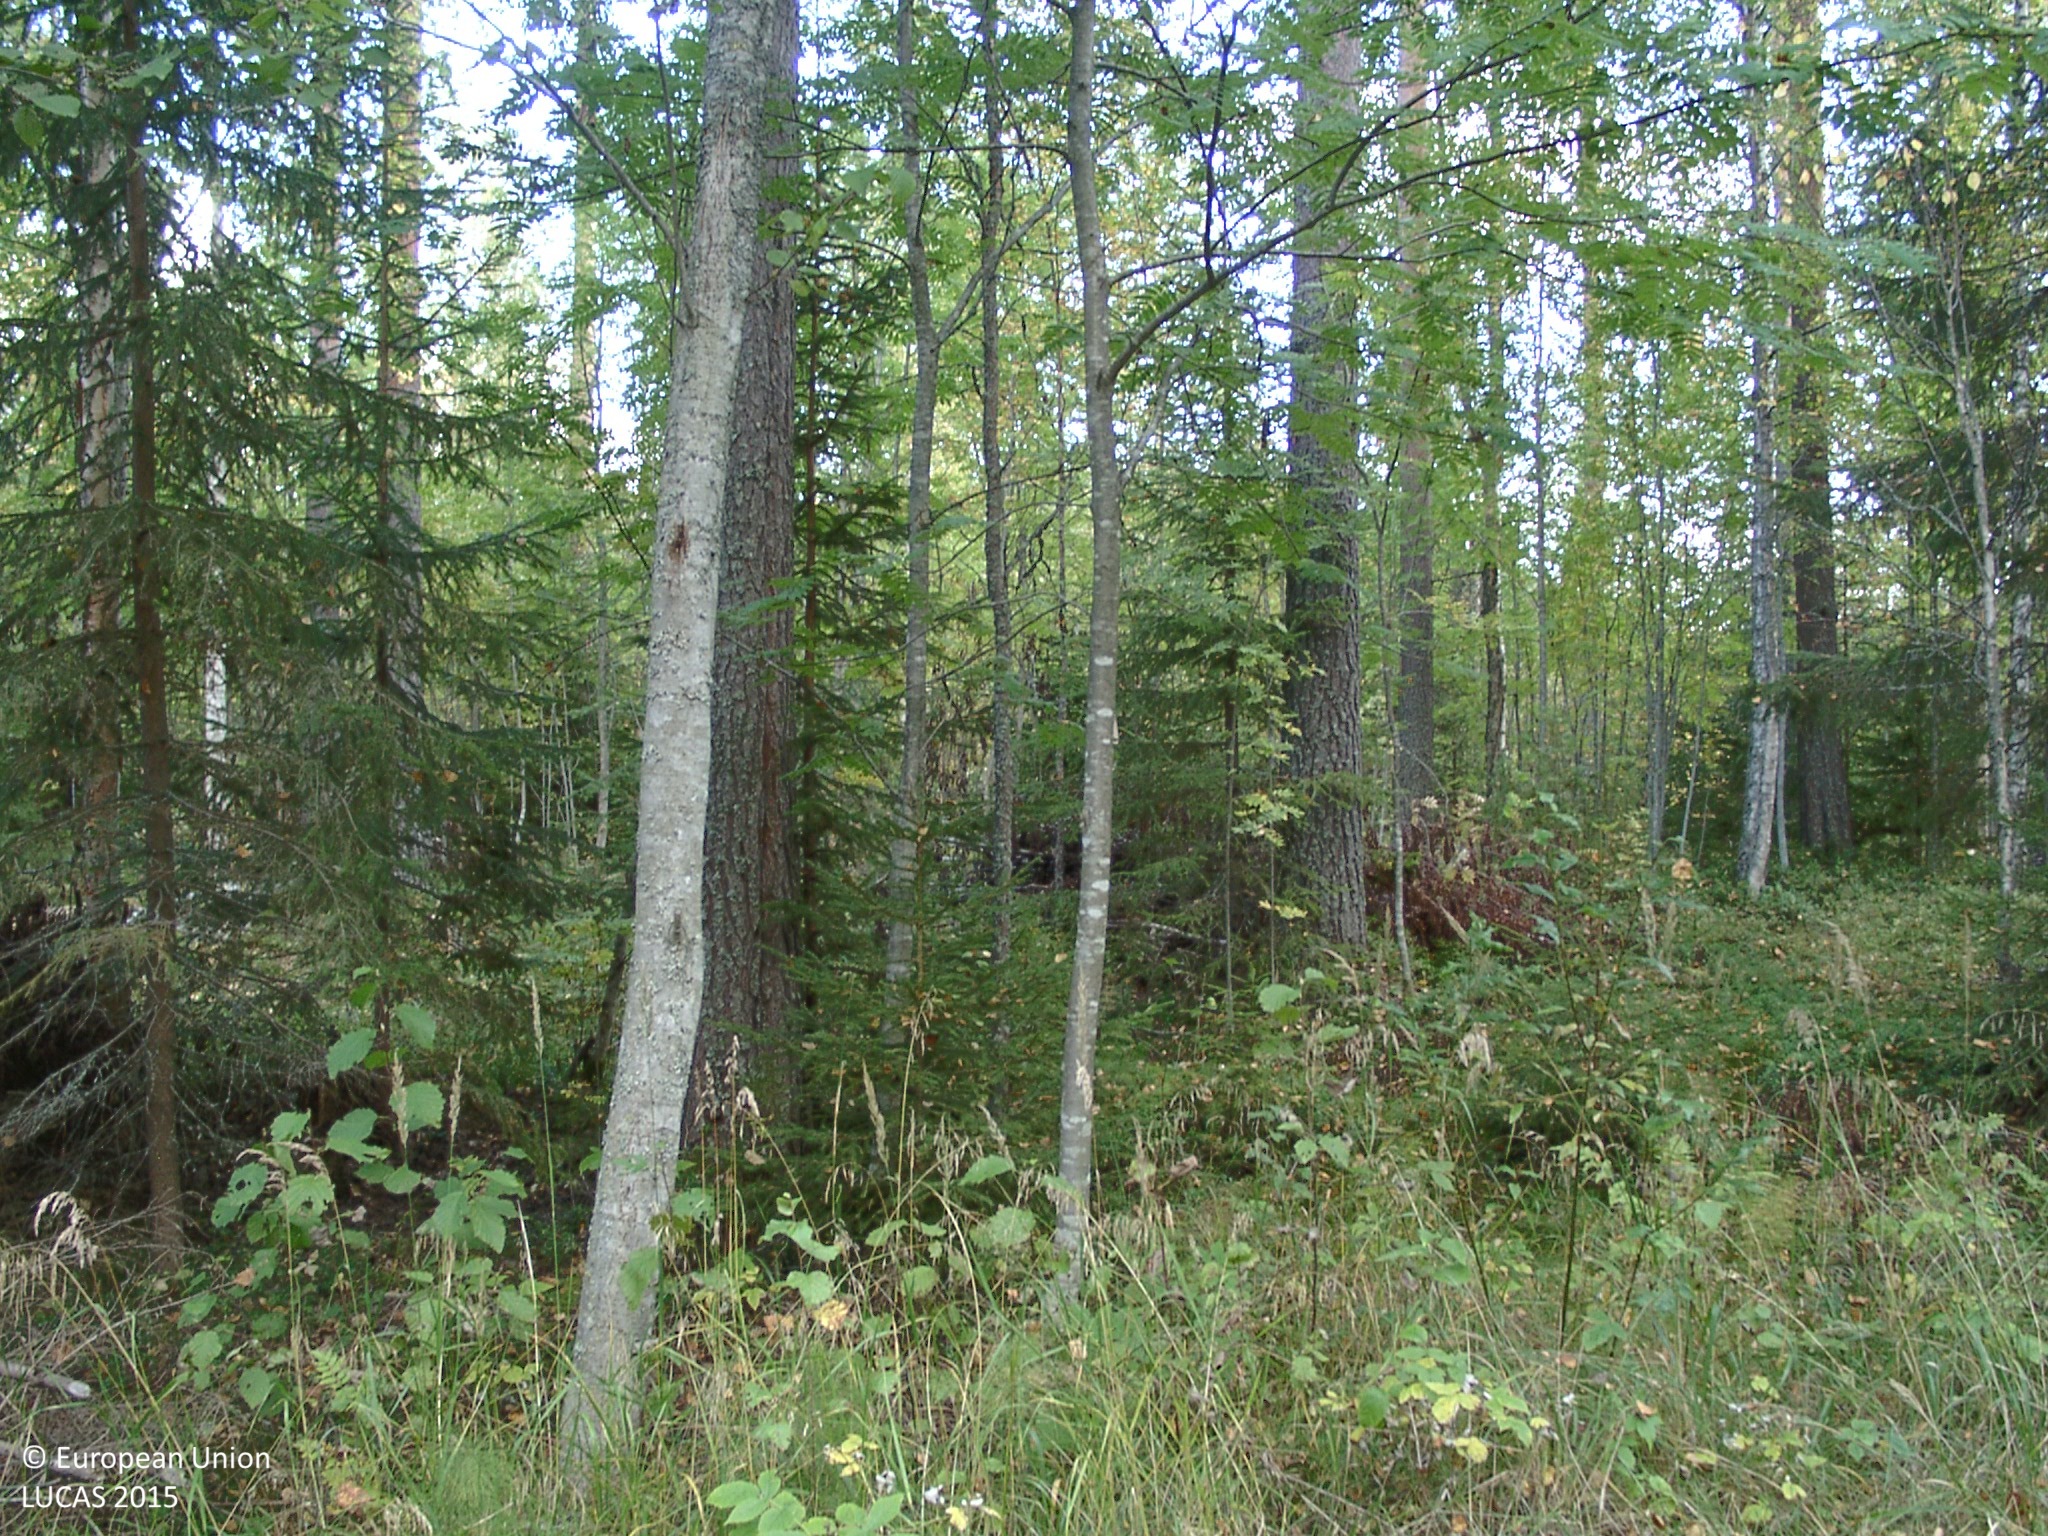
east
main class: Artificial land
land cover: Non built-up linear features
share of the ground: > 75 %
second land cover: Grassland without tree/shrub cover
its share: 50 - 75 %
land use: Road transport
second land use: Residential
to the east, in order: Shruby margins; Tracks; Grassland without tree/shrub cover; Pine dominated mixed woodland; Broadleaved woodland; Shruby margins; Ditches and canals; Grass margins; Temporary grasslands; Grass margins; Ditches and canals; Groves; Electric lines; Spruce dominated mixed woodland; Spruce dominated coniferous woodland; Grass margins; Tracks; Ditches and canals; Grassland without tree/shrub cover; Spruce dominated mixed woodland; Spruce dominated coniferous woodland
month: September
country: FI
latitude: 62.4907
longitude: 25.6206
